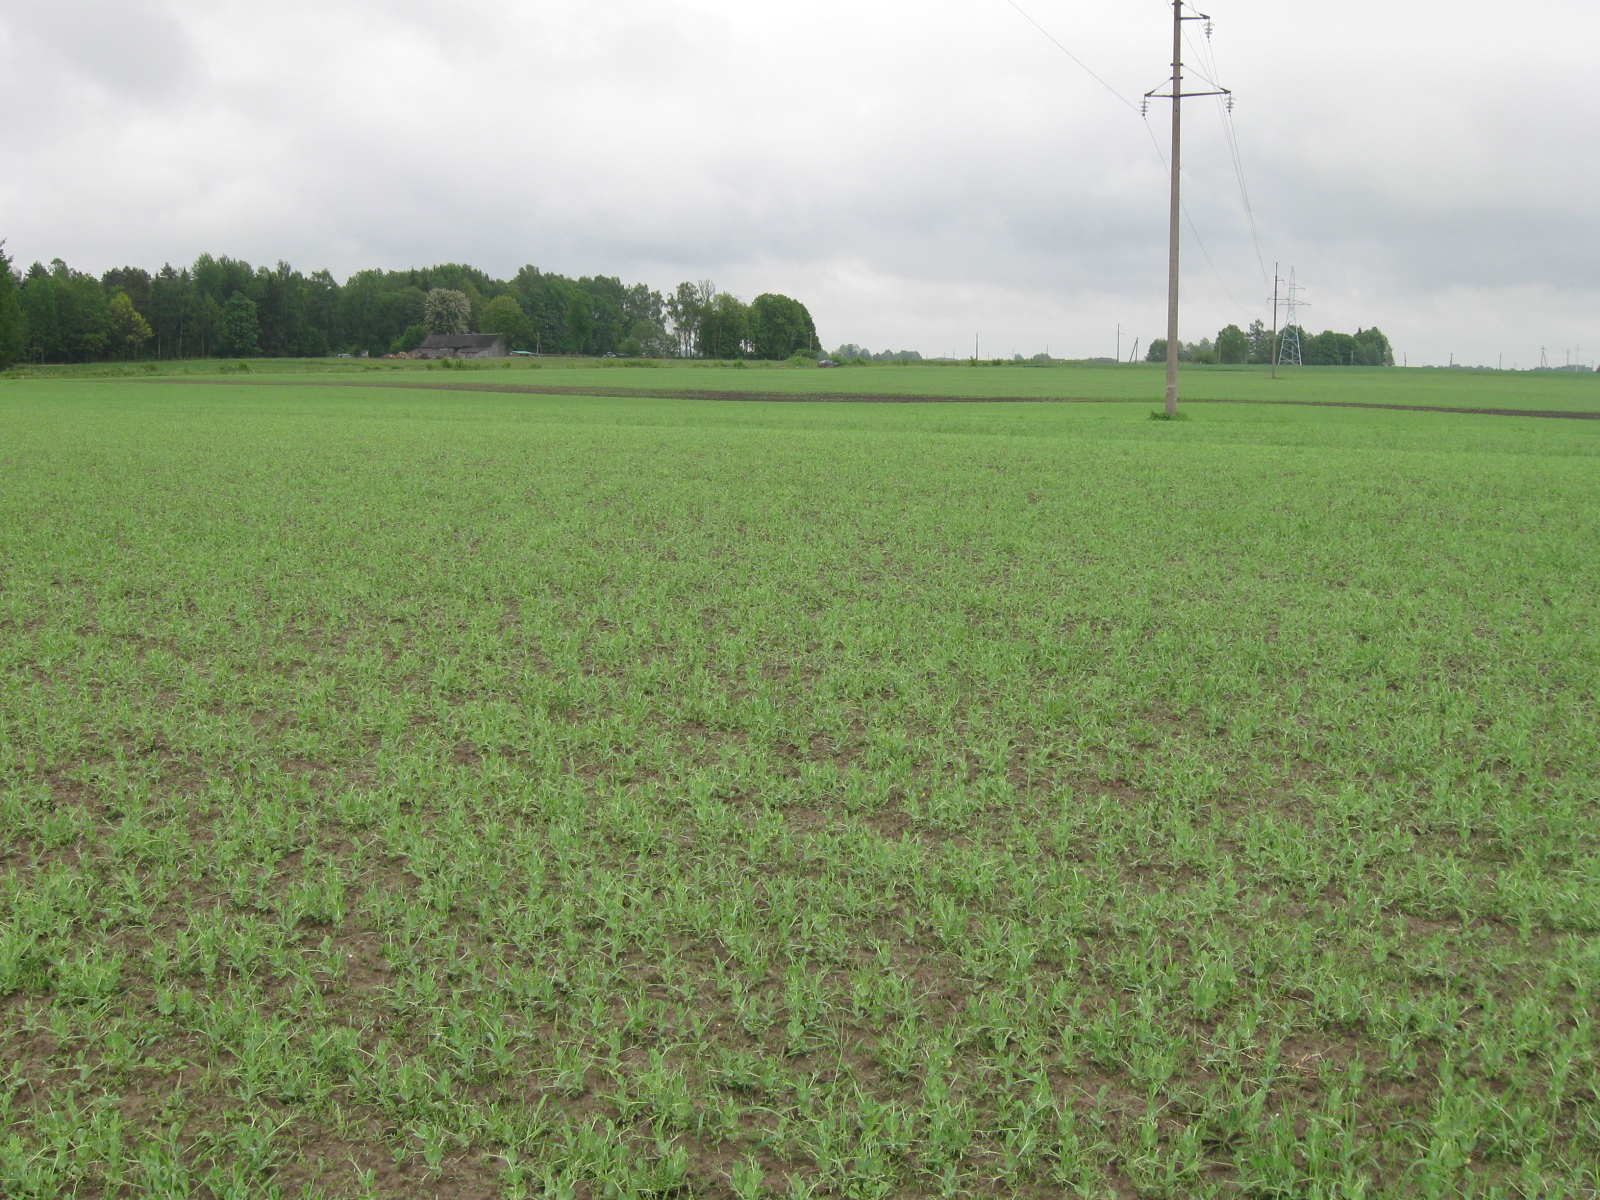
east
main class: Cropland
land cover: Dry pulses
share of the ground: > 75 %
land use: Agriculture (excluding fallow land and kitchen gardens)
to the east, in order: Dry pulses; Electric lines; Dry pulses
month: May
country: LT
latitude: 54.9636
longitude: 22.7653
